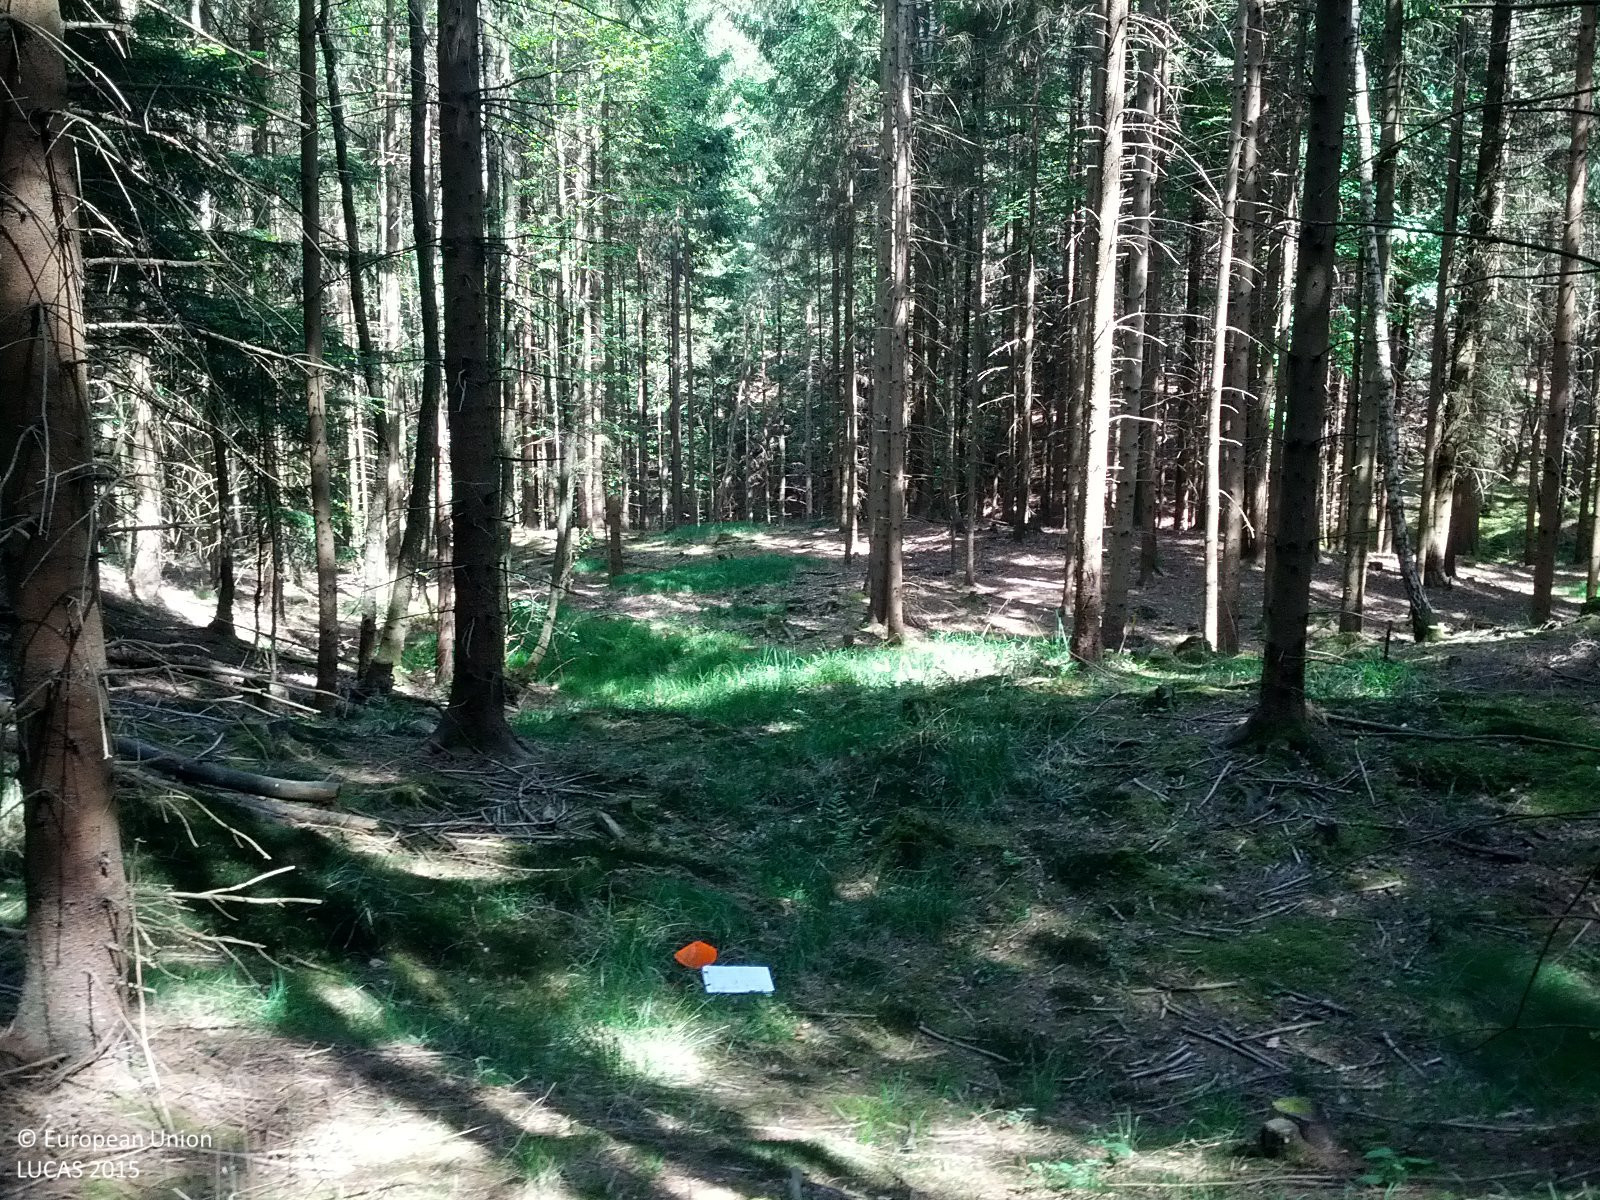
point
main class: Woodland
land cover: Spruce dominated coniferous woodland
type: boreal forest
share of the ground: > 75 %
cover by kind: coniferous forest trees 80 %, lichens and mosses 10 %, broadleaved forest trees 5 %, herbaceous plants 5 %
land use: Forestry
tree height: > 5 m
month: May
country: AT
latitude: 47.4057
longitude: 16.0847
